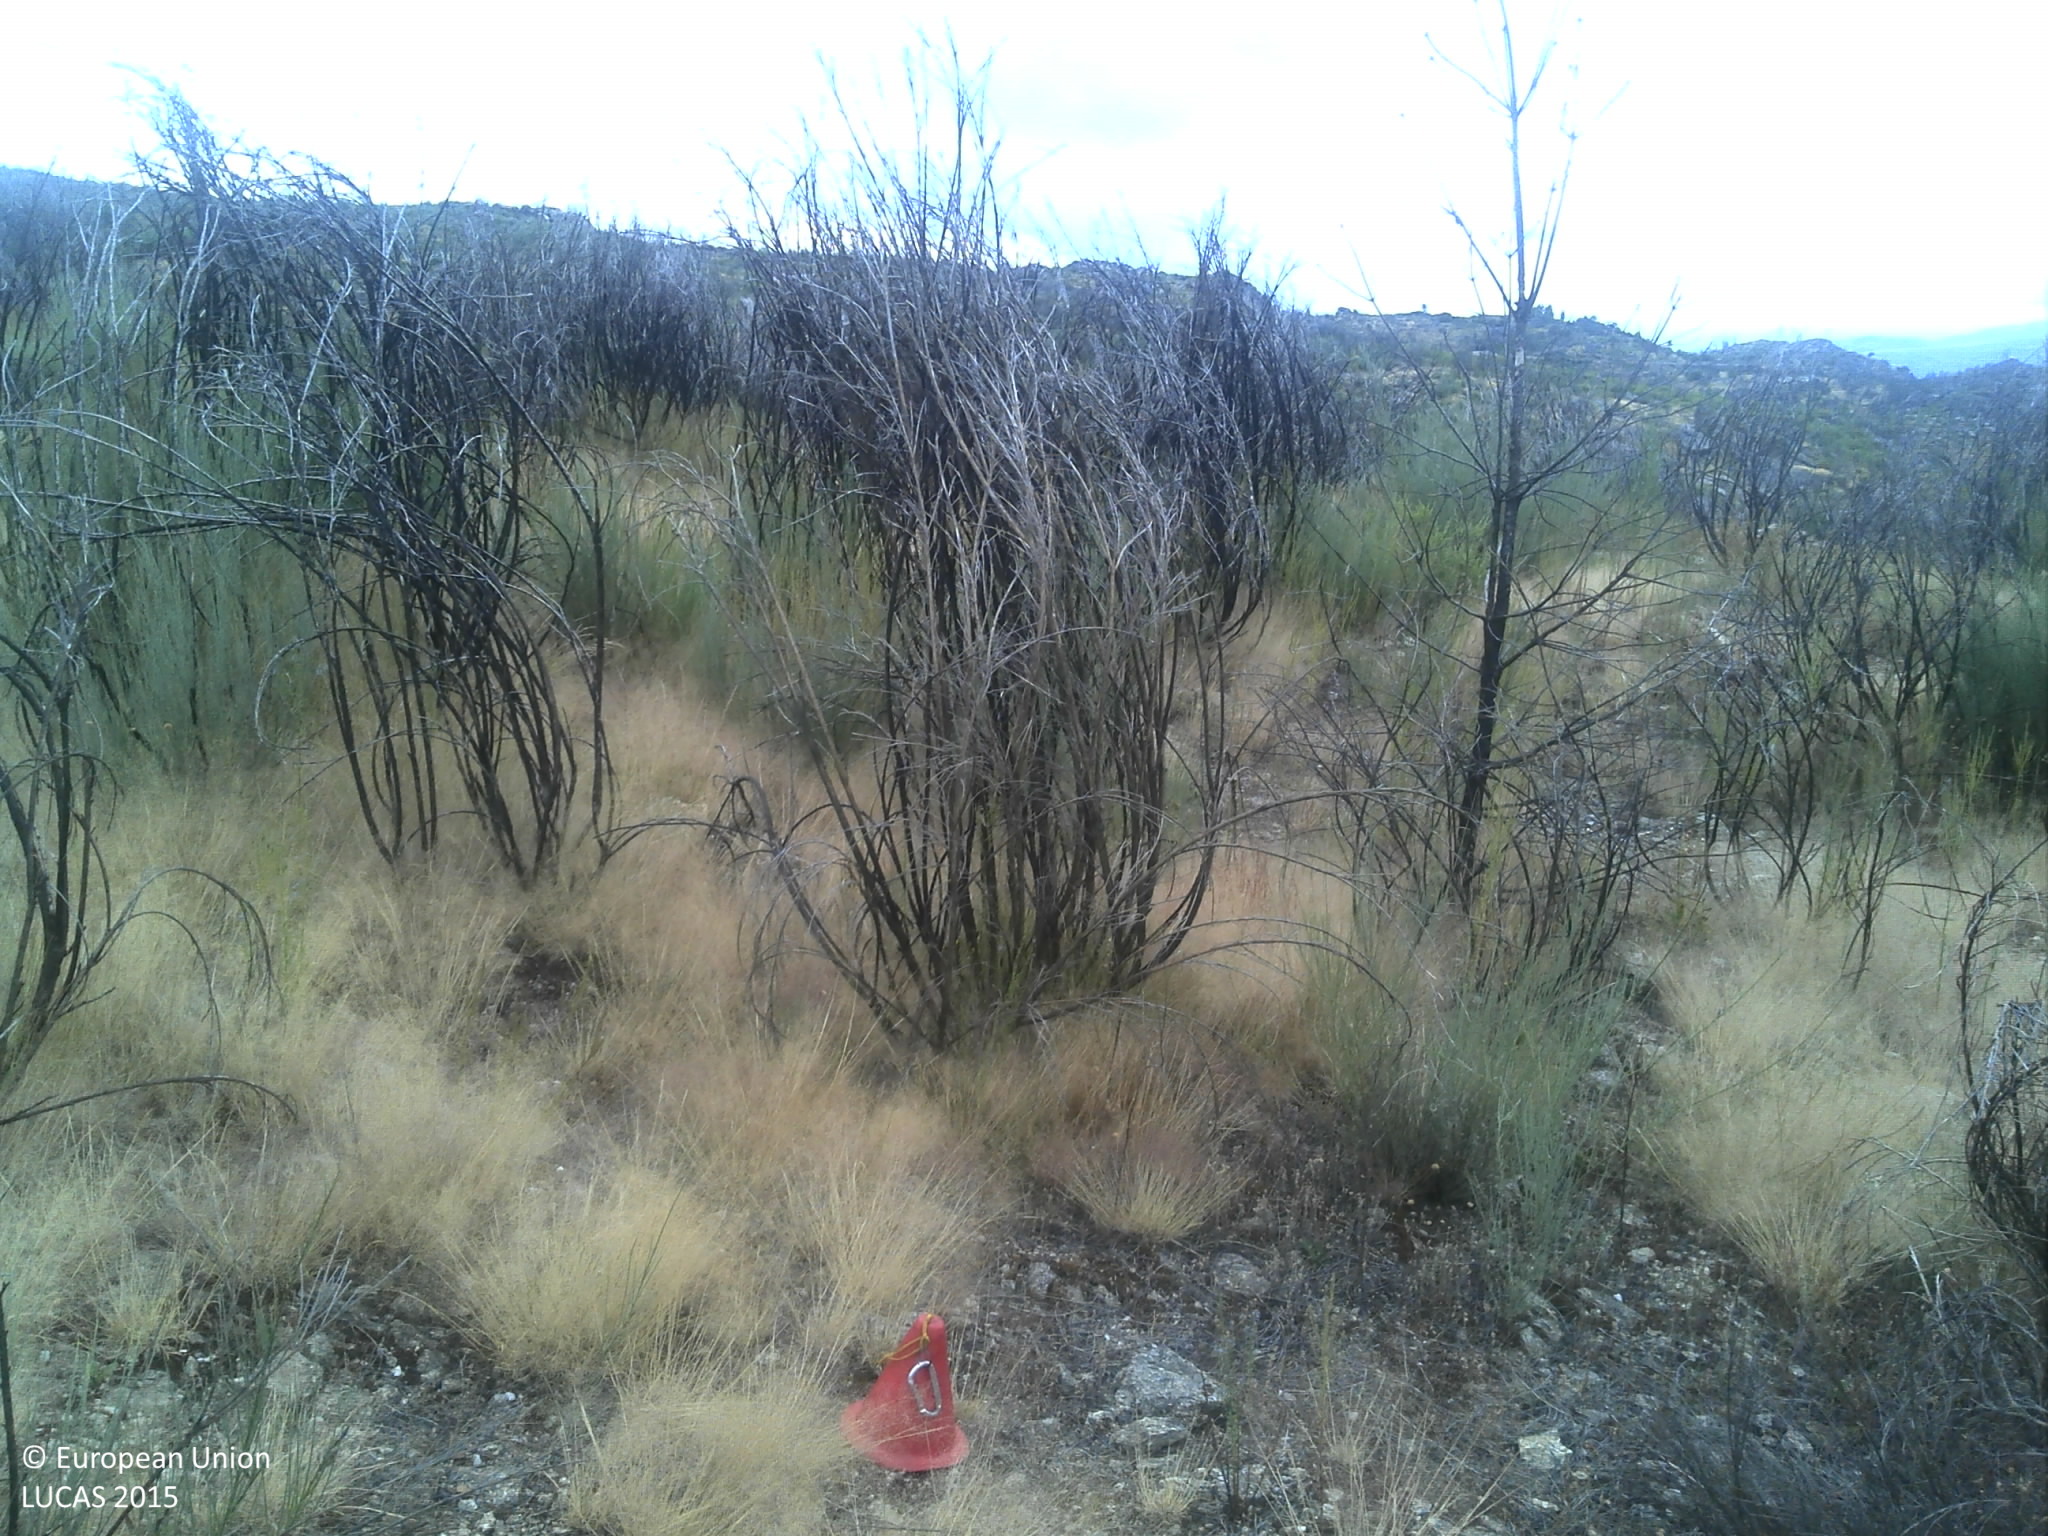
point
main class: Shrubland
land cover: Shrubland without tree cover
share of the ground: 50 - 75 %
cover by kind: shrubs 75 %, herbaceous plants 20 %, unconsolidated bare surface 5 %
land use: Semi-natural and natural areas not in use
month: July
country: PT
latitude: 41.3765
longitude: -7.6950
